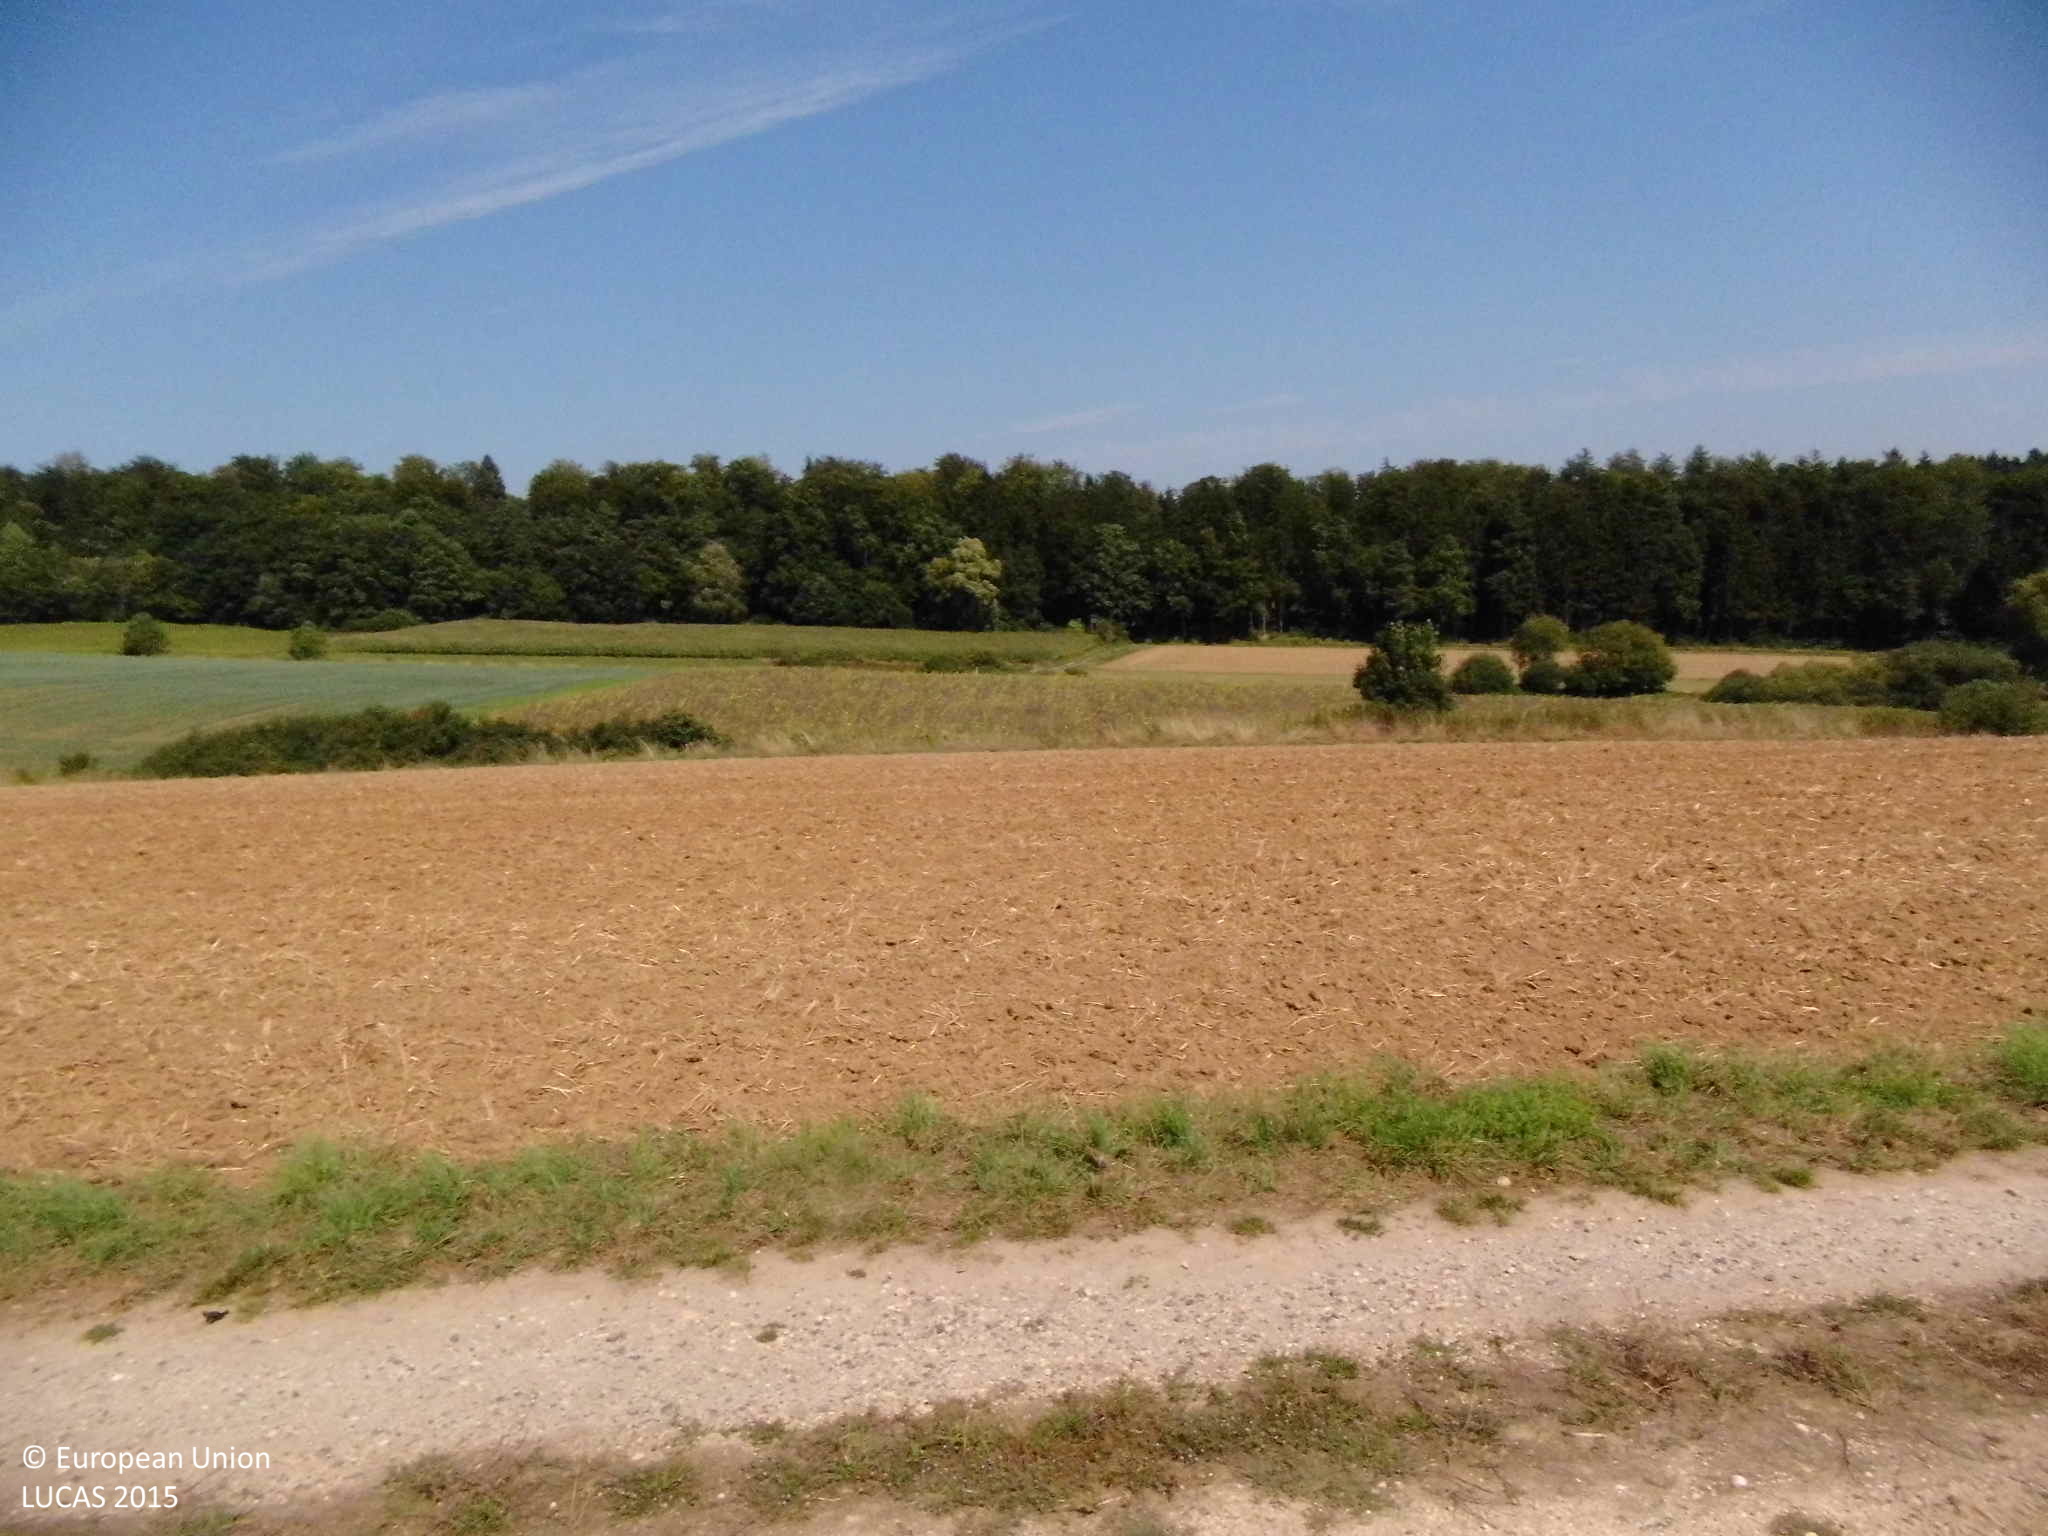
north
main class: Cropland
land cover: Rye
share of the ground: 25 - 50 %
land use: Agriculture (excluding fallow land and kitchen gardens)
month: August
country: DE
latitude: 50.4368
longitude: 8.0152
